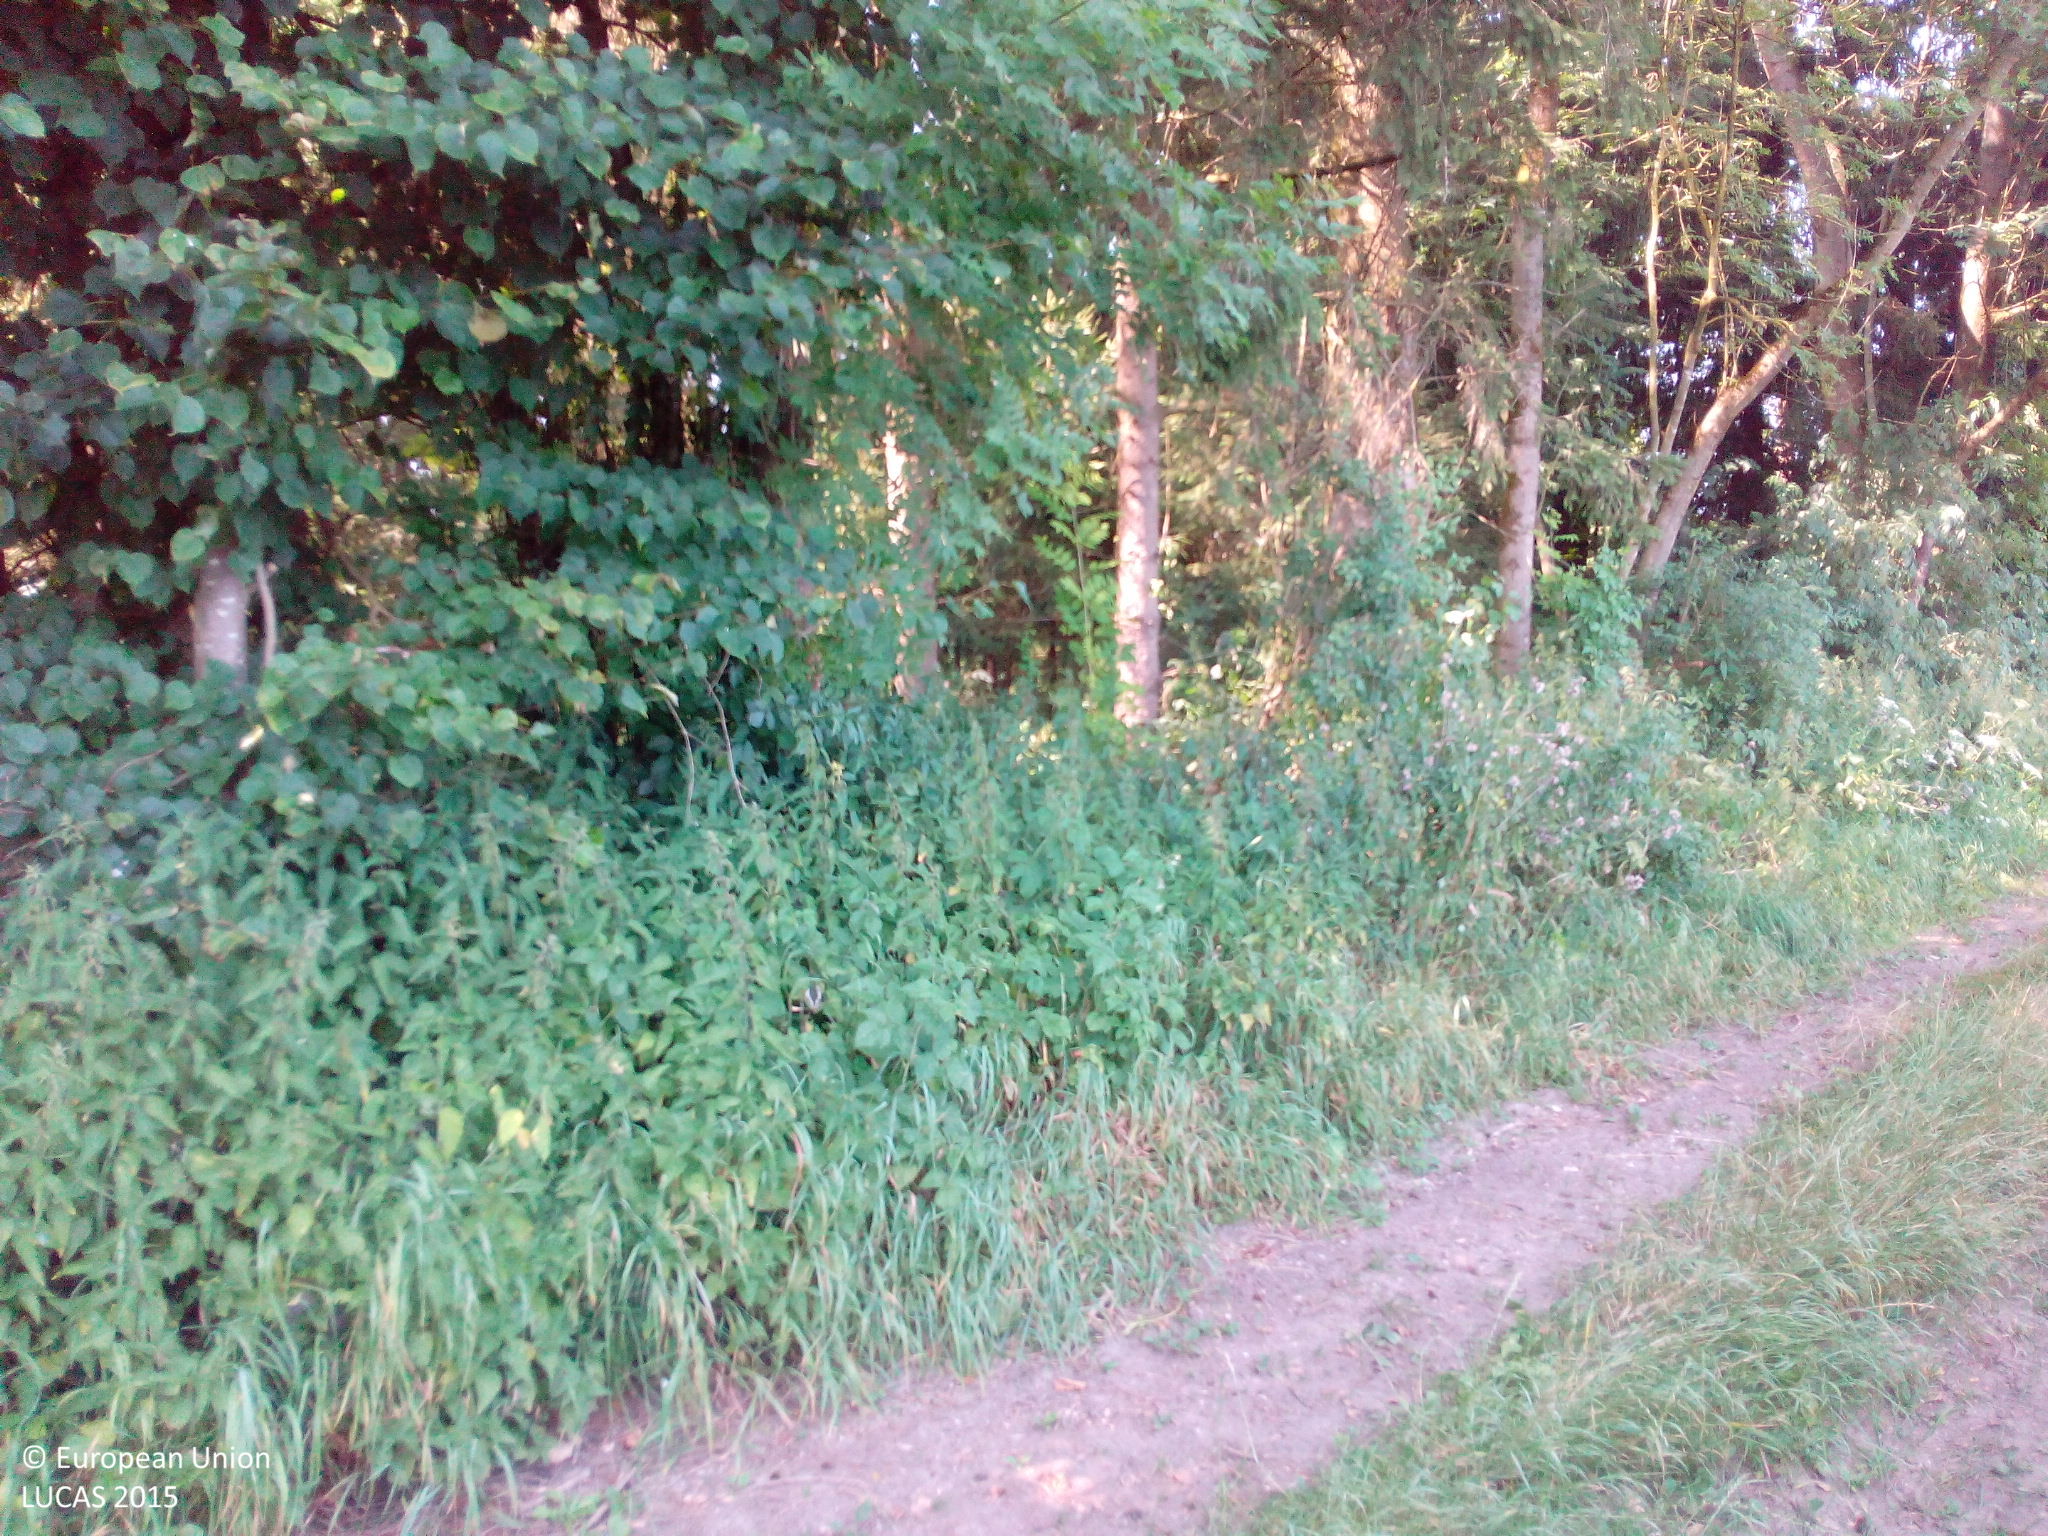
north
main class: Cropland
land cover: Maize
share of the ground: > 75 %
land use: Agriculture (excluding fallow land and kitchen gardens)
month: July
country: DE
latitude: 48.2216
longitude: 12.8930
